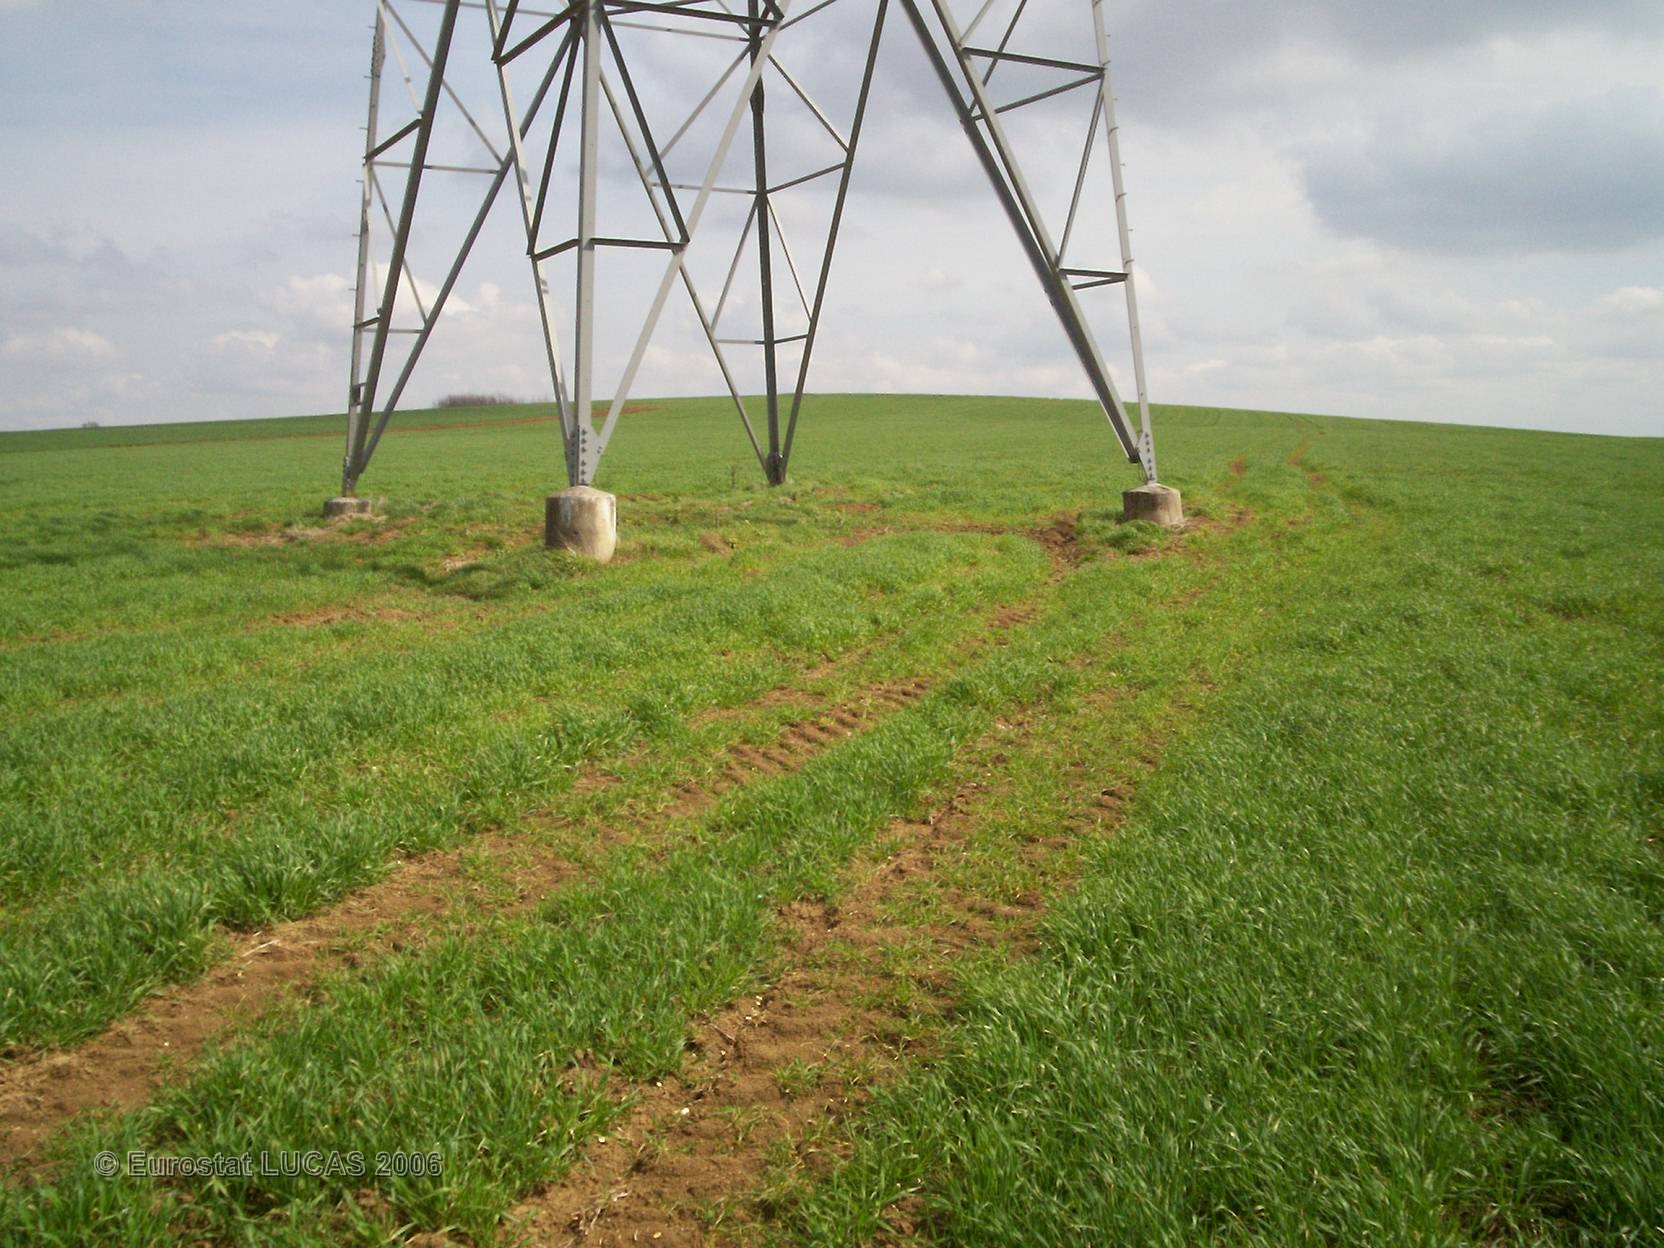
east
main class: Cropland
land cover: Barley
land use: Agriculture (excluding fallow land and kitchen gardens)
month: April
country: FR
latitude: 50.7774
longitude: 2.3709
